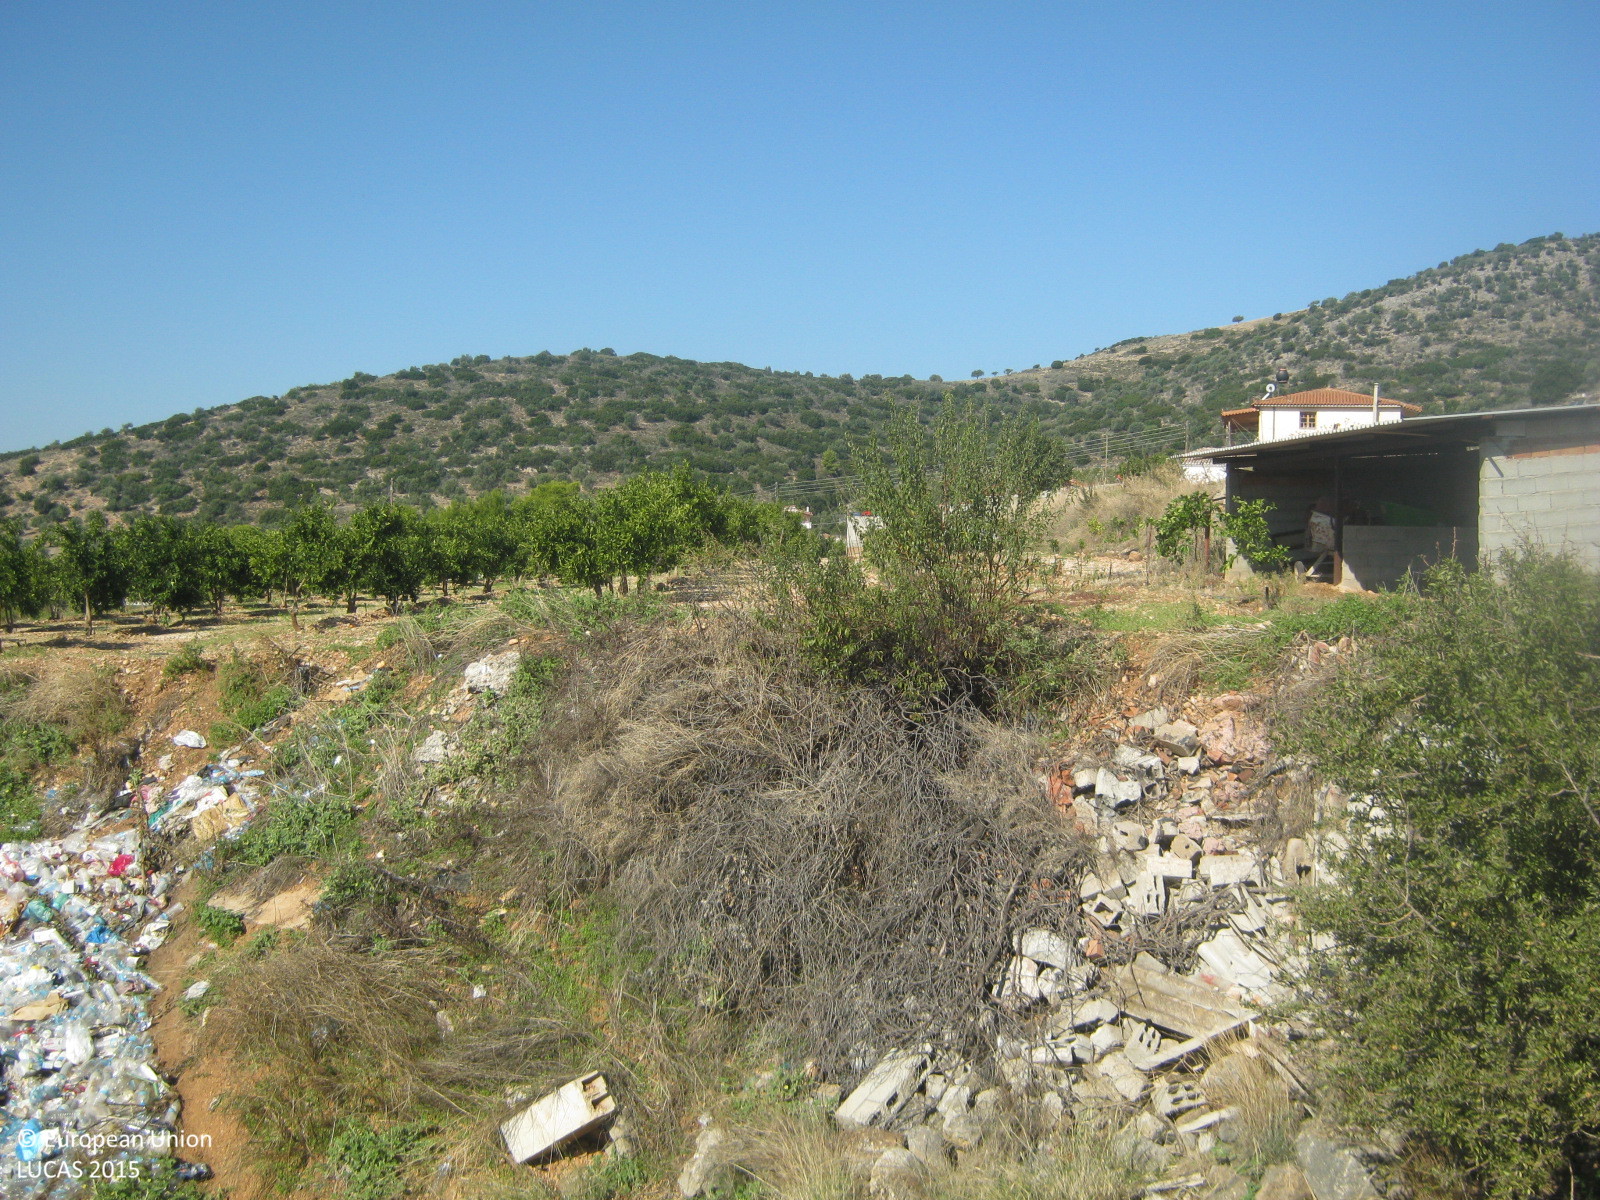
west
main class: Grassland
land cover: Grassland with sparse tree/shrub cover
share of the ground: 50 - 75 %
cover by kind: unconsolidated bare surface 55 %, herbaceous plants 30 %, shrubs 10 %, broadleaved forest trees 5 %
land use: Semi-natural and natural areas not in use
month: October
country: GR
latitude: 37.6803
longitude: 22.8373
